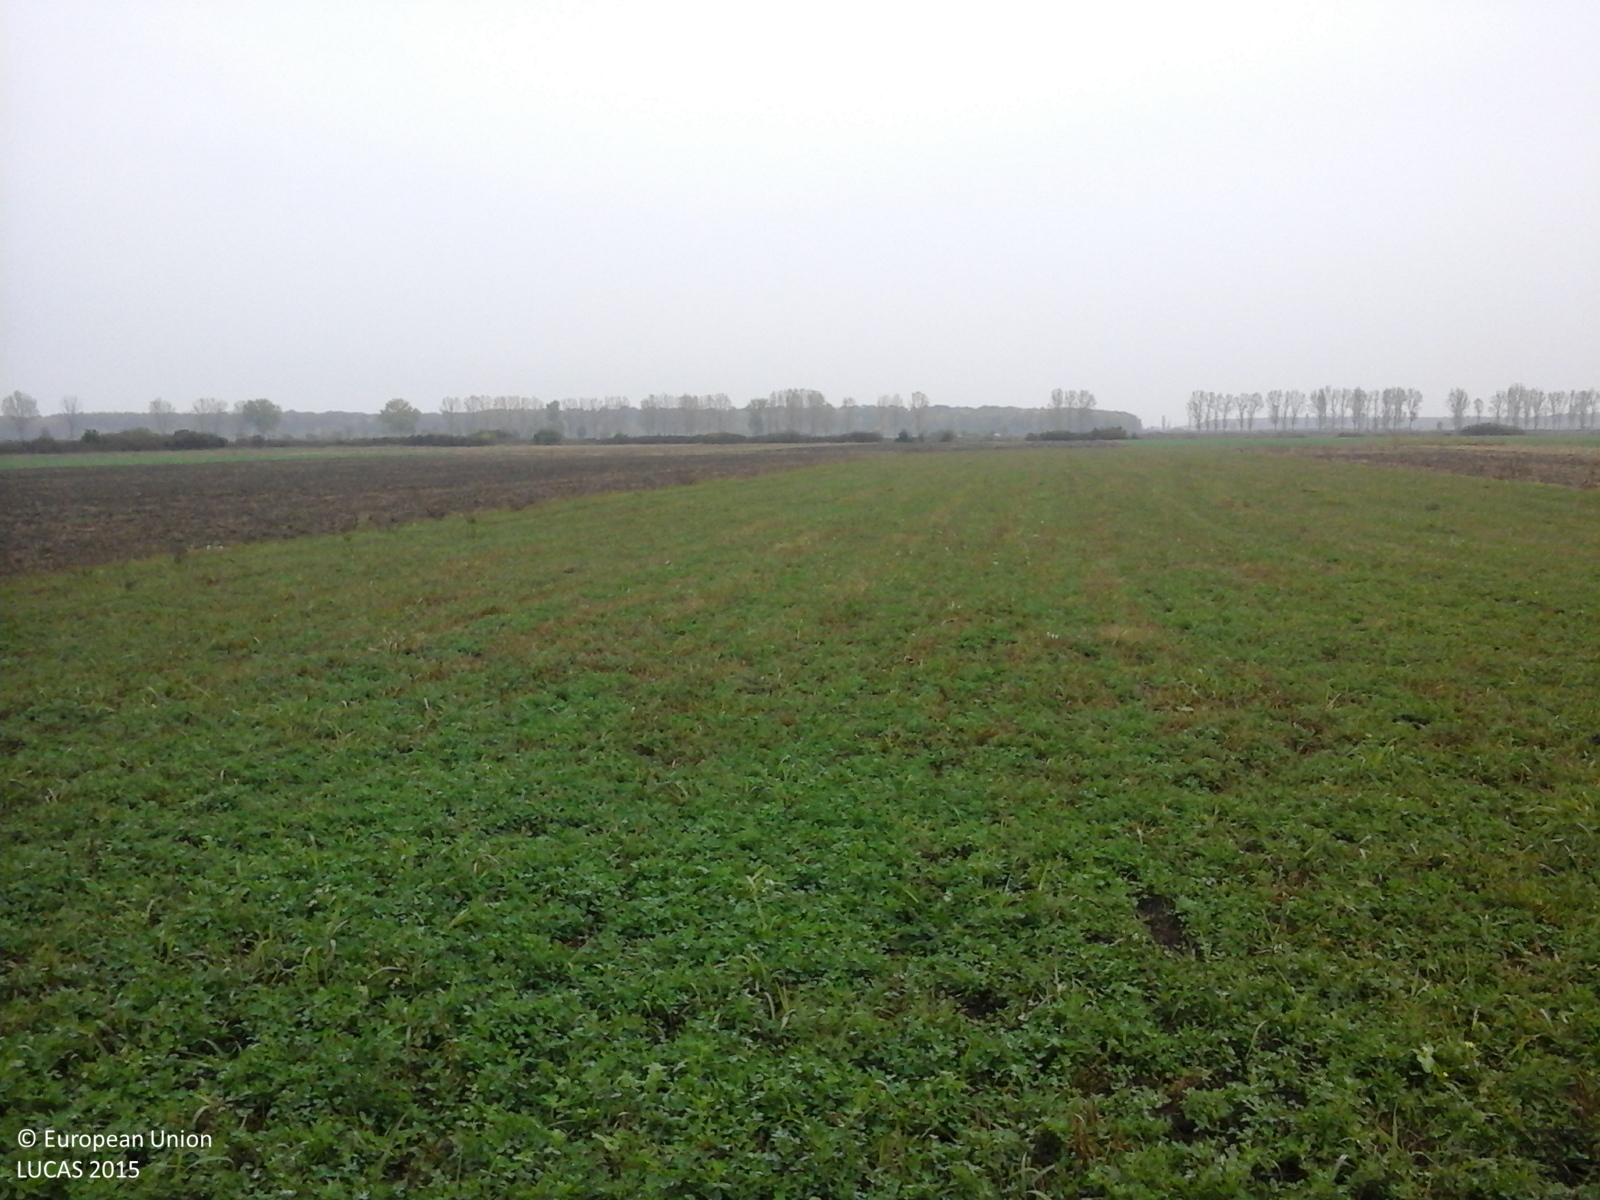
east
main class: Cropland
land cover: Maize
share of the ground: > 75 %
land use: Agriculture (excluding fallow land and kitchen gardens)
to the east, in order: Maize; Grass margins; Lucerne; Common wheat; Other bare soil; Rape and turnip rape; Grass margins; Tracks; Grass margins; Maize
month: October
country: RO
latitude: 44.8418
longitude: 26.0094
